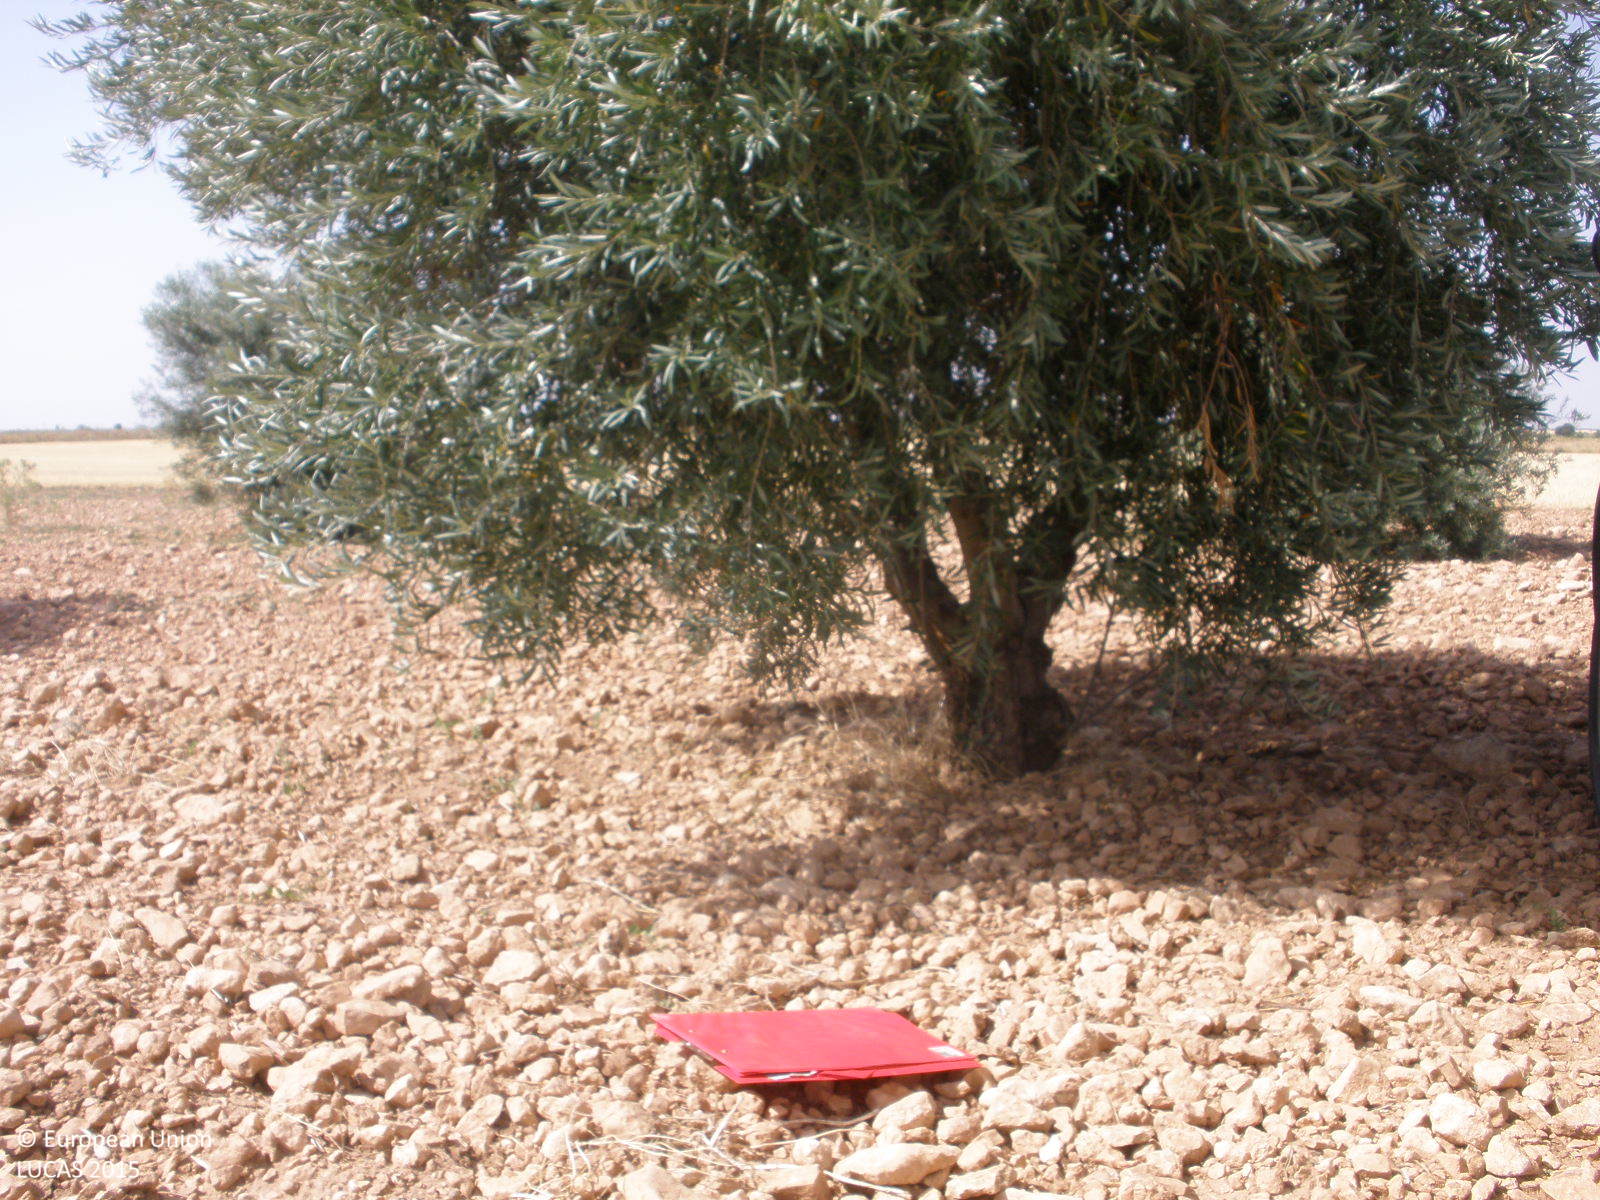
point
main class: Cropland
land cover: Olive groves
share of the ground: 25 - 50 %
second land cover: Other bare soil
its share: > 75 %
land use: Agriculture (excluding fallow land and kitchen gardens)
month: July
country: ES
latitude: 39.9293
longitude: -3.4018
